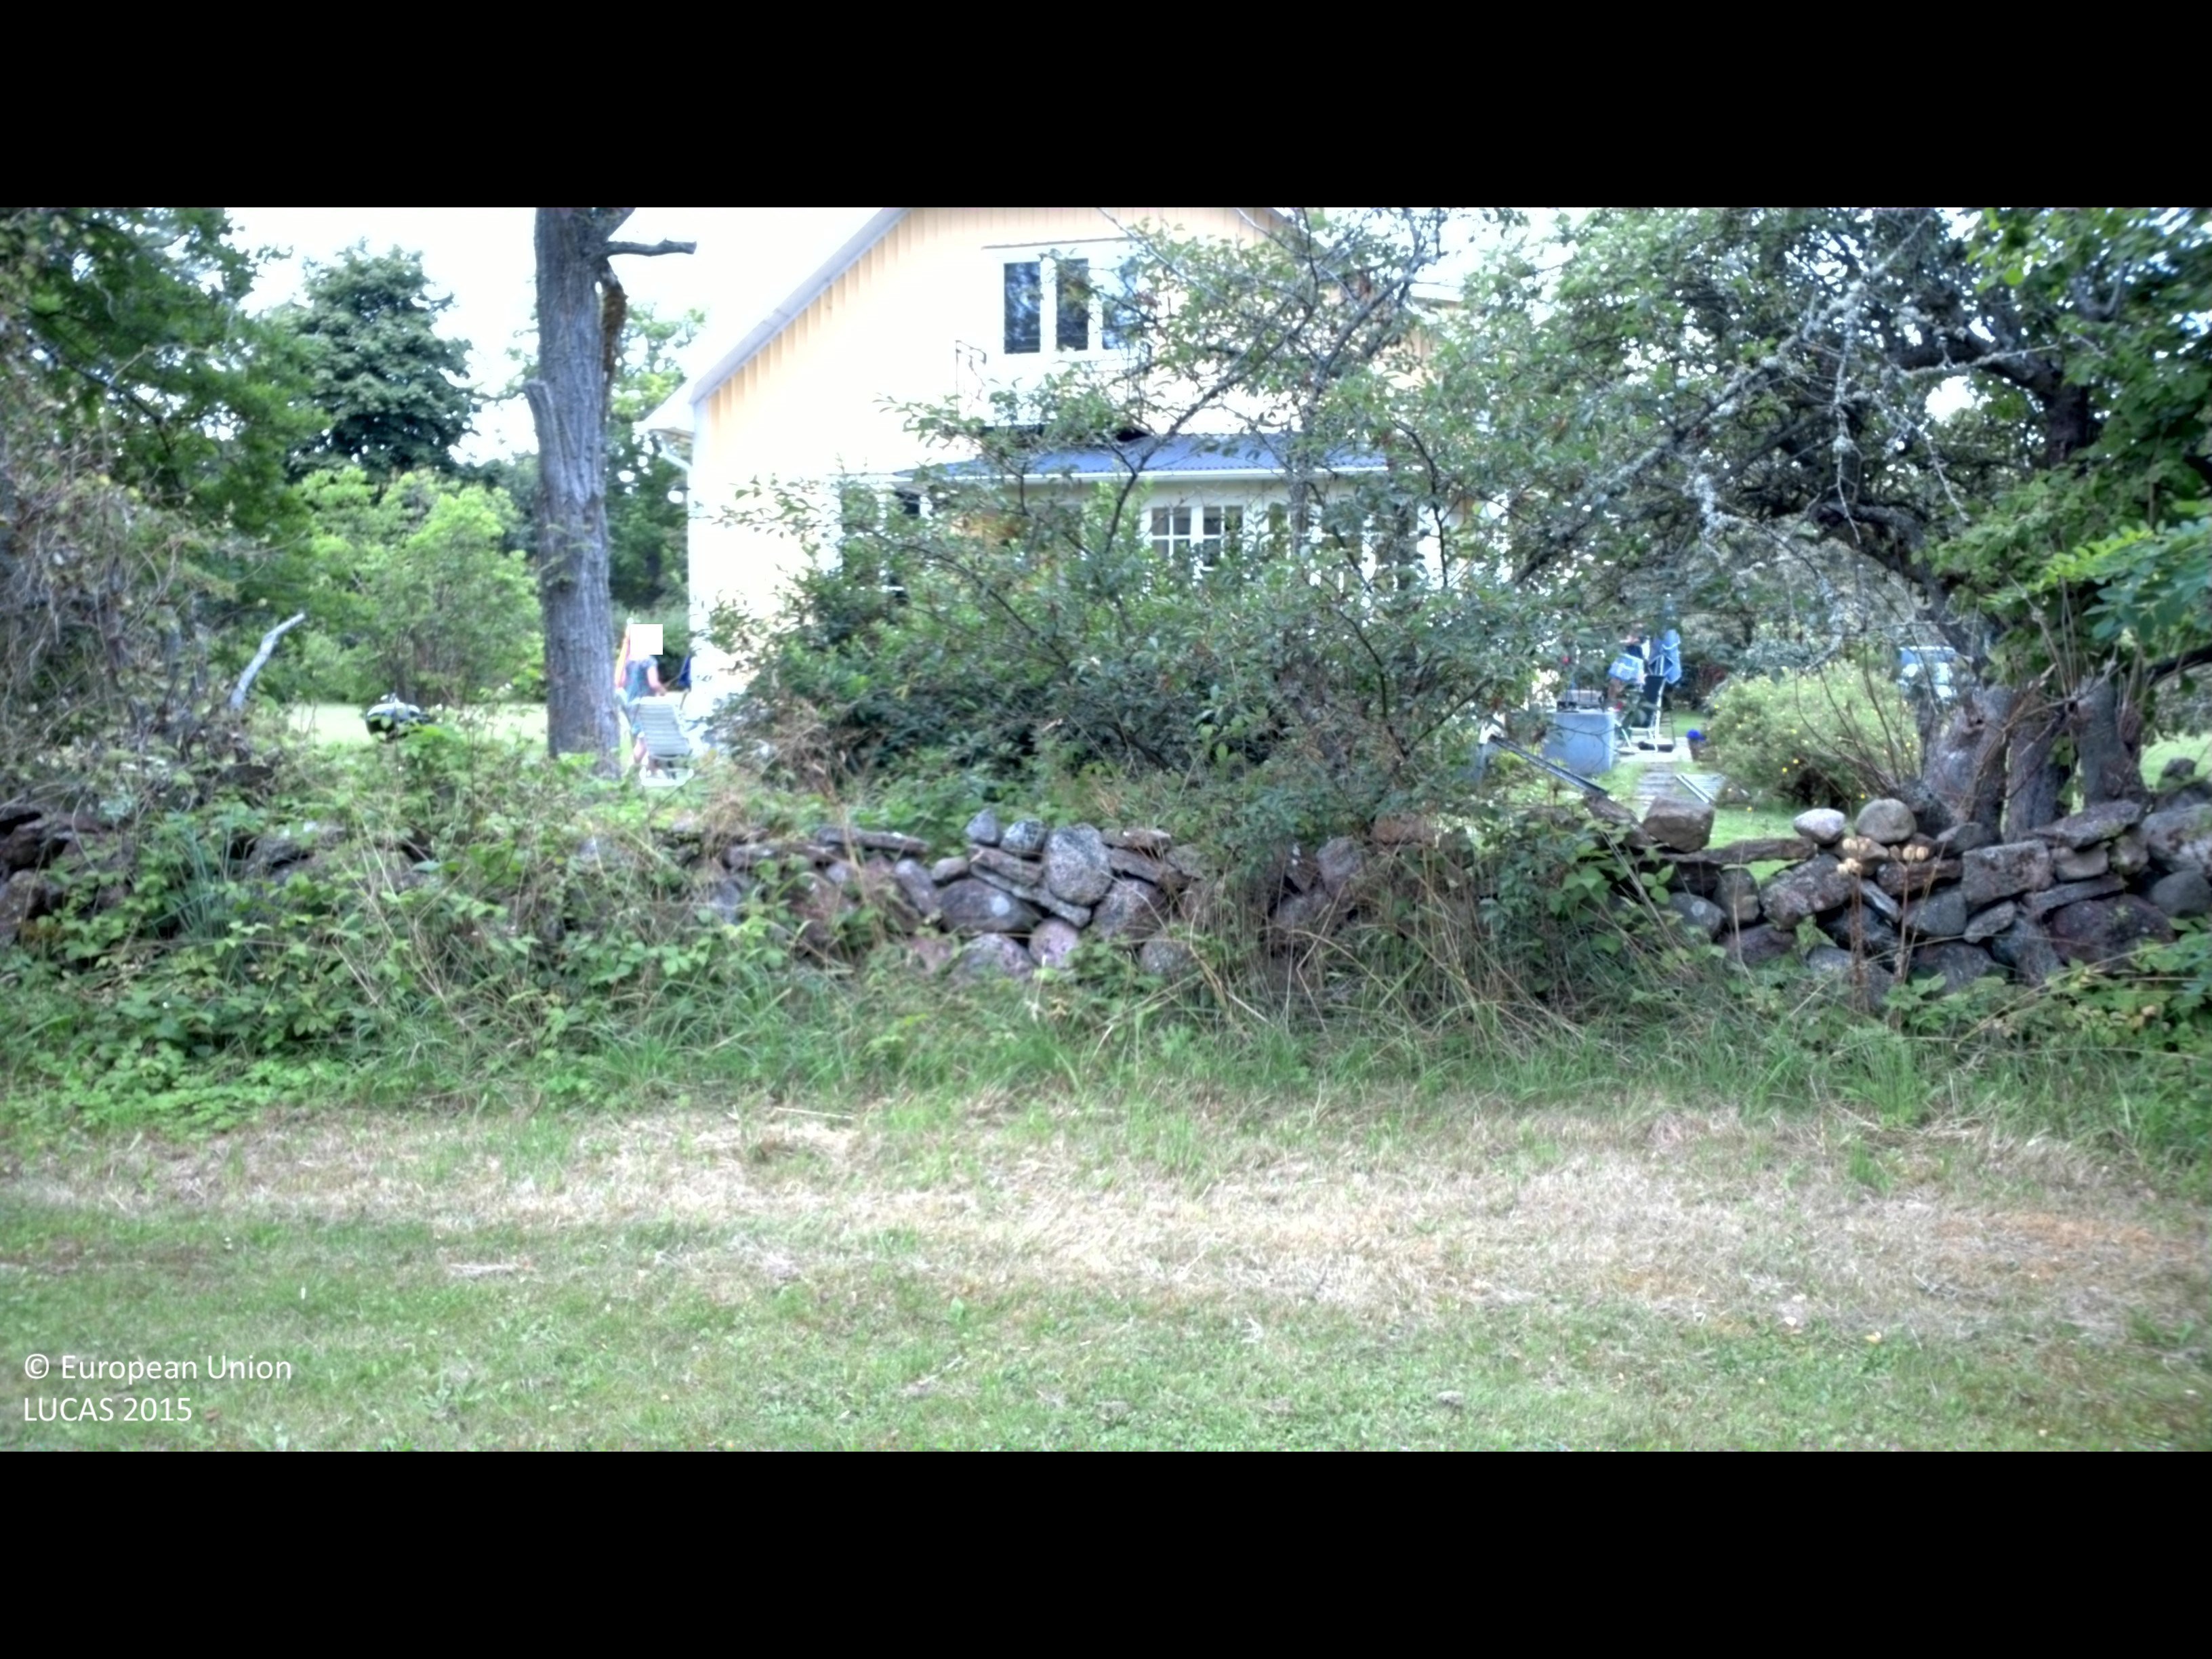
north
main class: Woodland
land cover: Broadleaved woodland
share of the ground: 10 - 25 %
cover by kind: herbaceous plants 75 %, broadleaved forest trees 25 %
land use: Residential
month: July
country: SE
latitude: 57.0844
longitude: 16.9153
